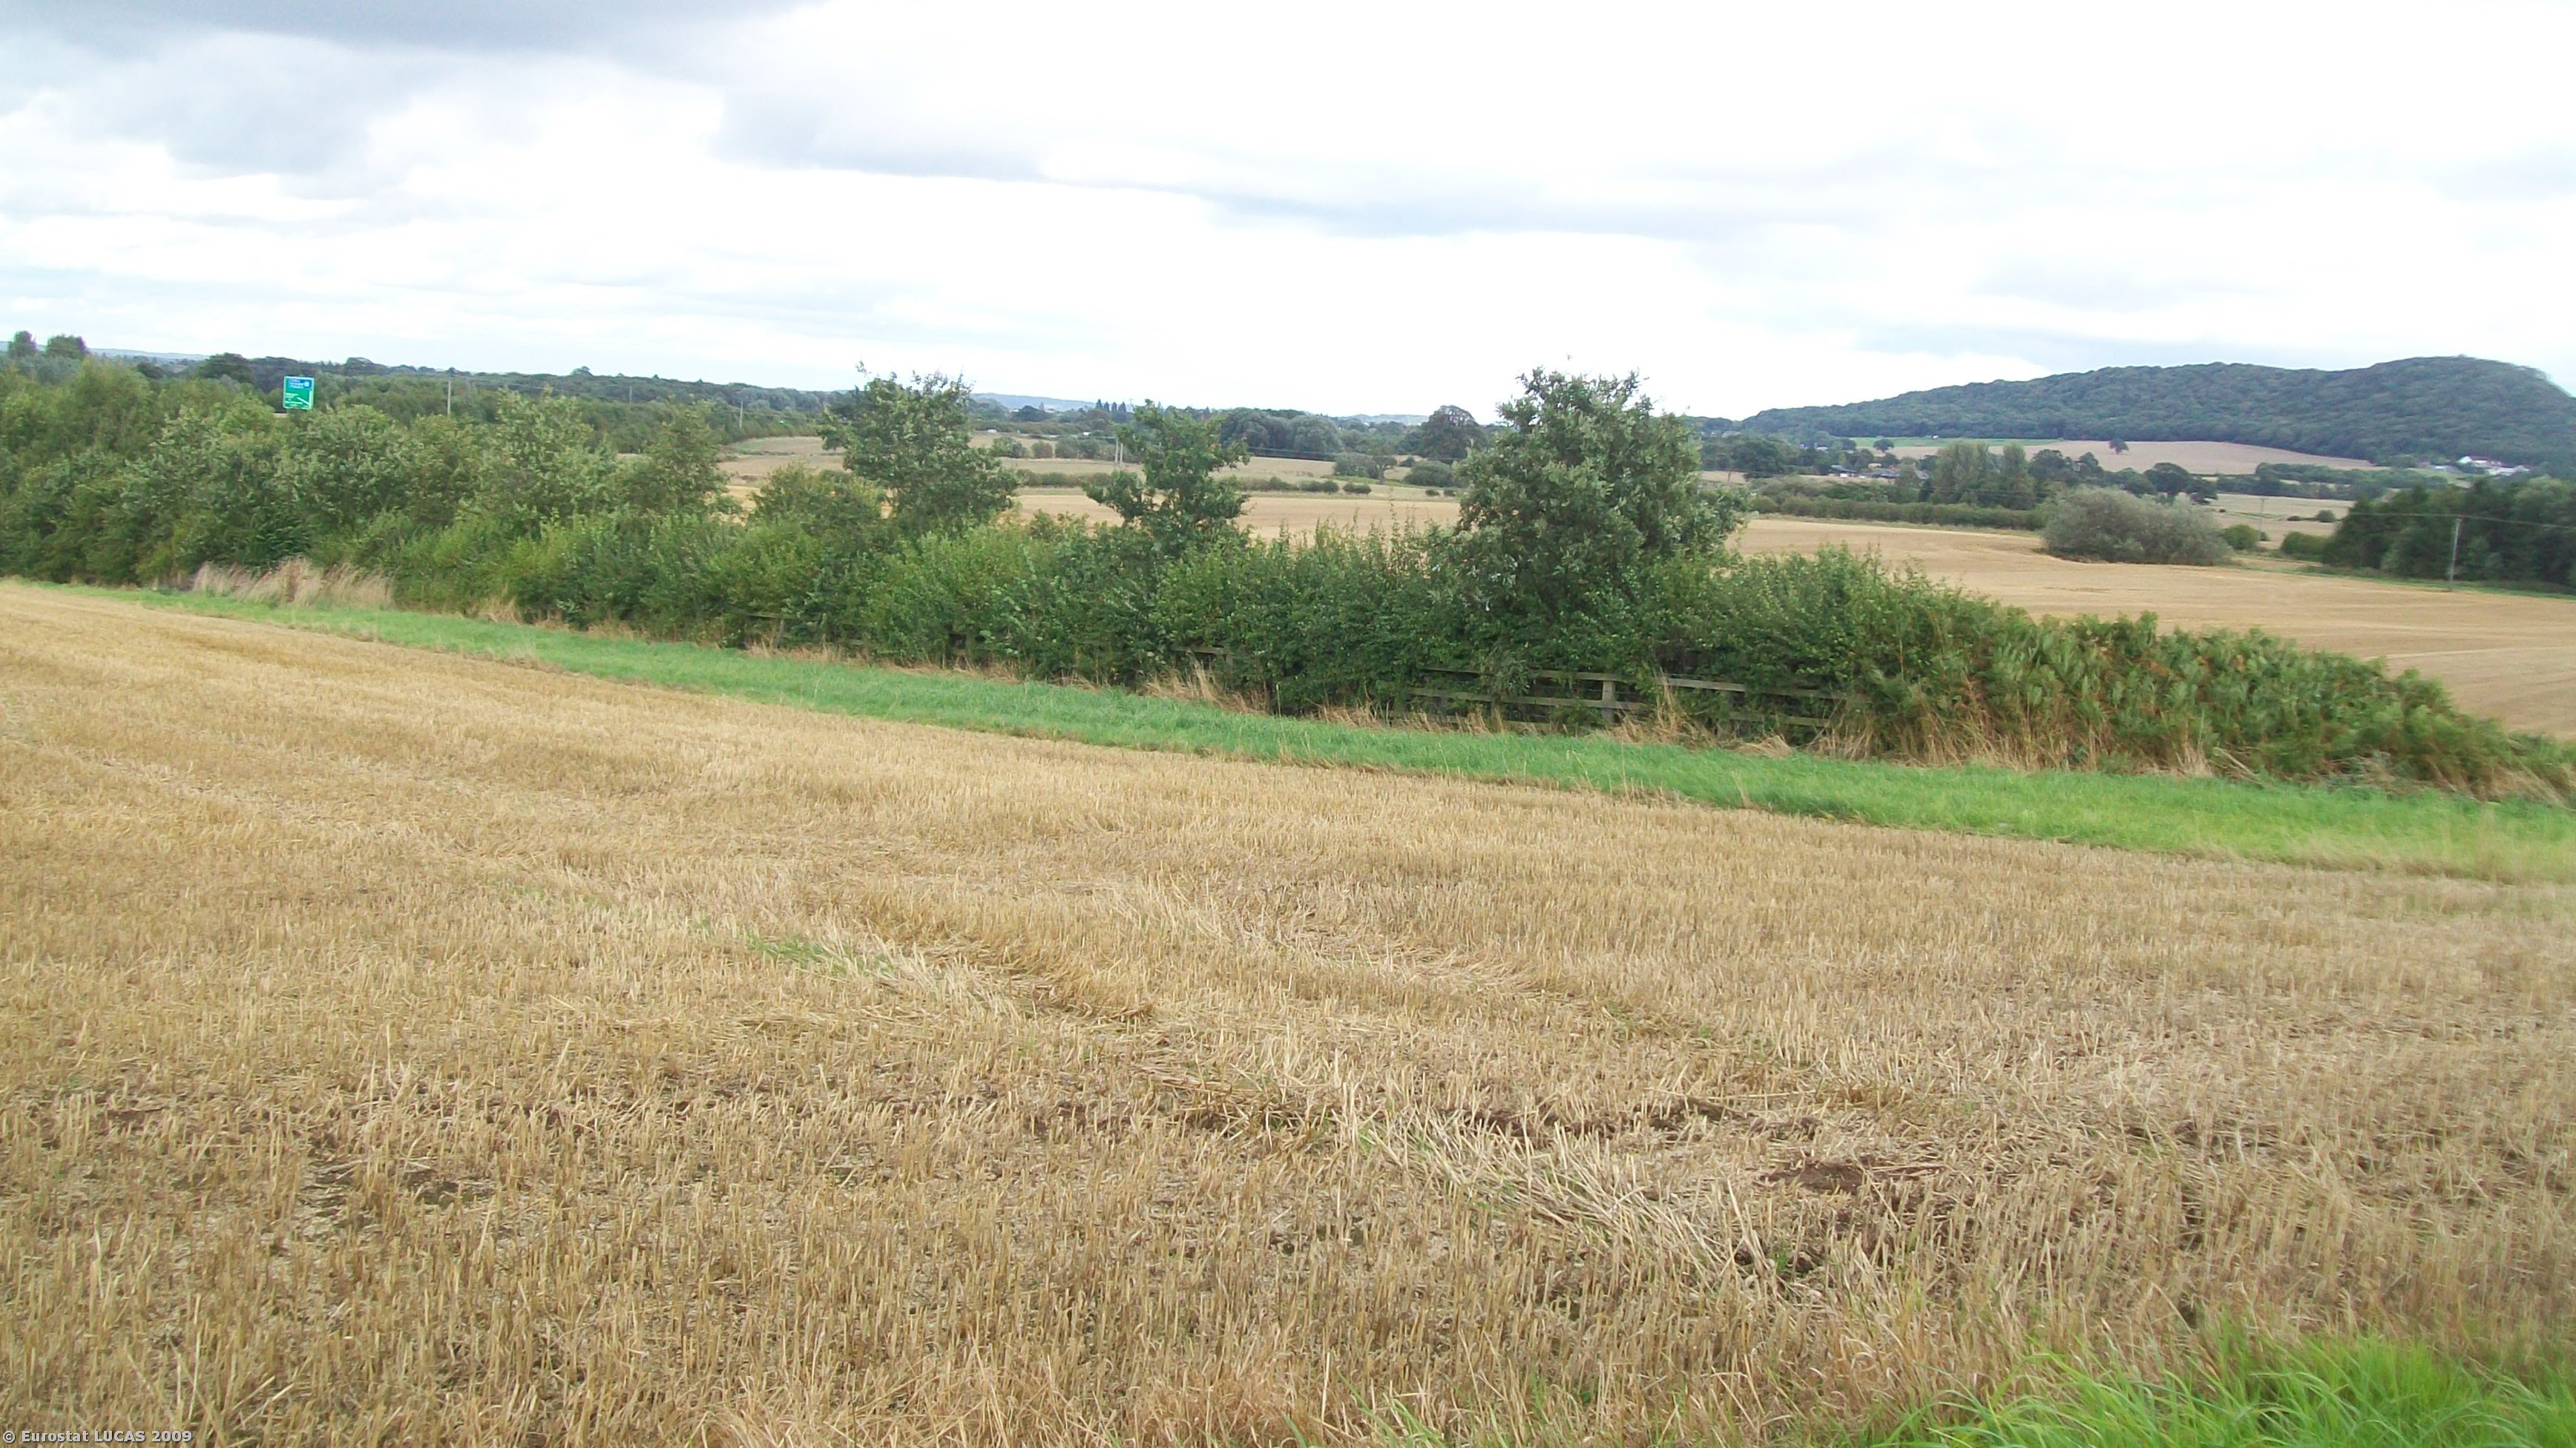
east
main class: Grassland
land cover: Grassland without tree/shrub cover
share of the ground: > 75 %
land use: Agriculture (excluding fallow land and kitchen gardens)
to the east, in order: Grassland without tree/shrub cover; Common wheat; Grassland without tree/shrub cover; Fences; Managed hedges; Grass margins; Paved roads, cycling and walking lanes; Grass margins; Managed hedges; Fences; Grass margins; Tracks; Common wheat
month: September
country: GB
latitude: 52.6892
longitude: -2.5686
